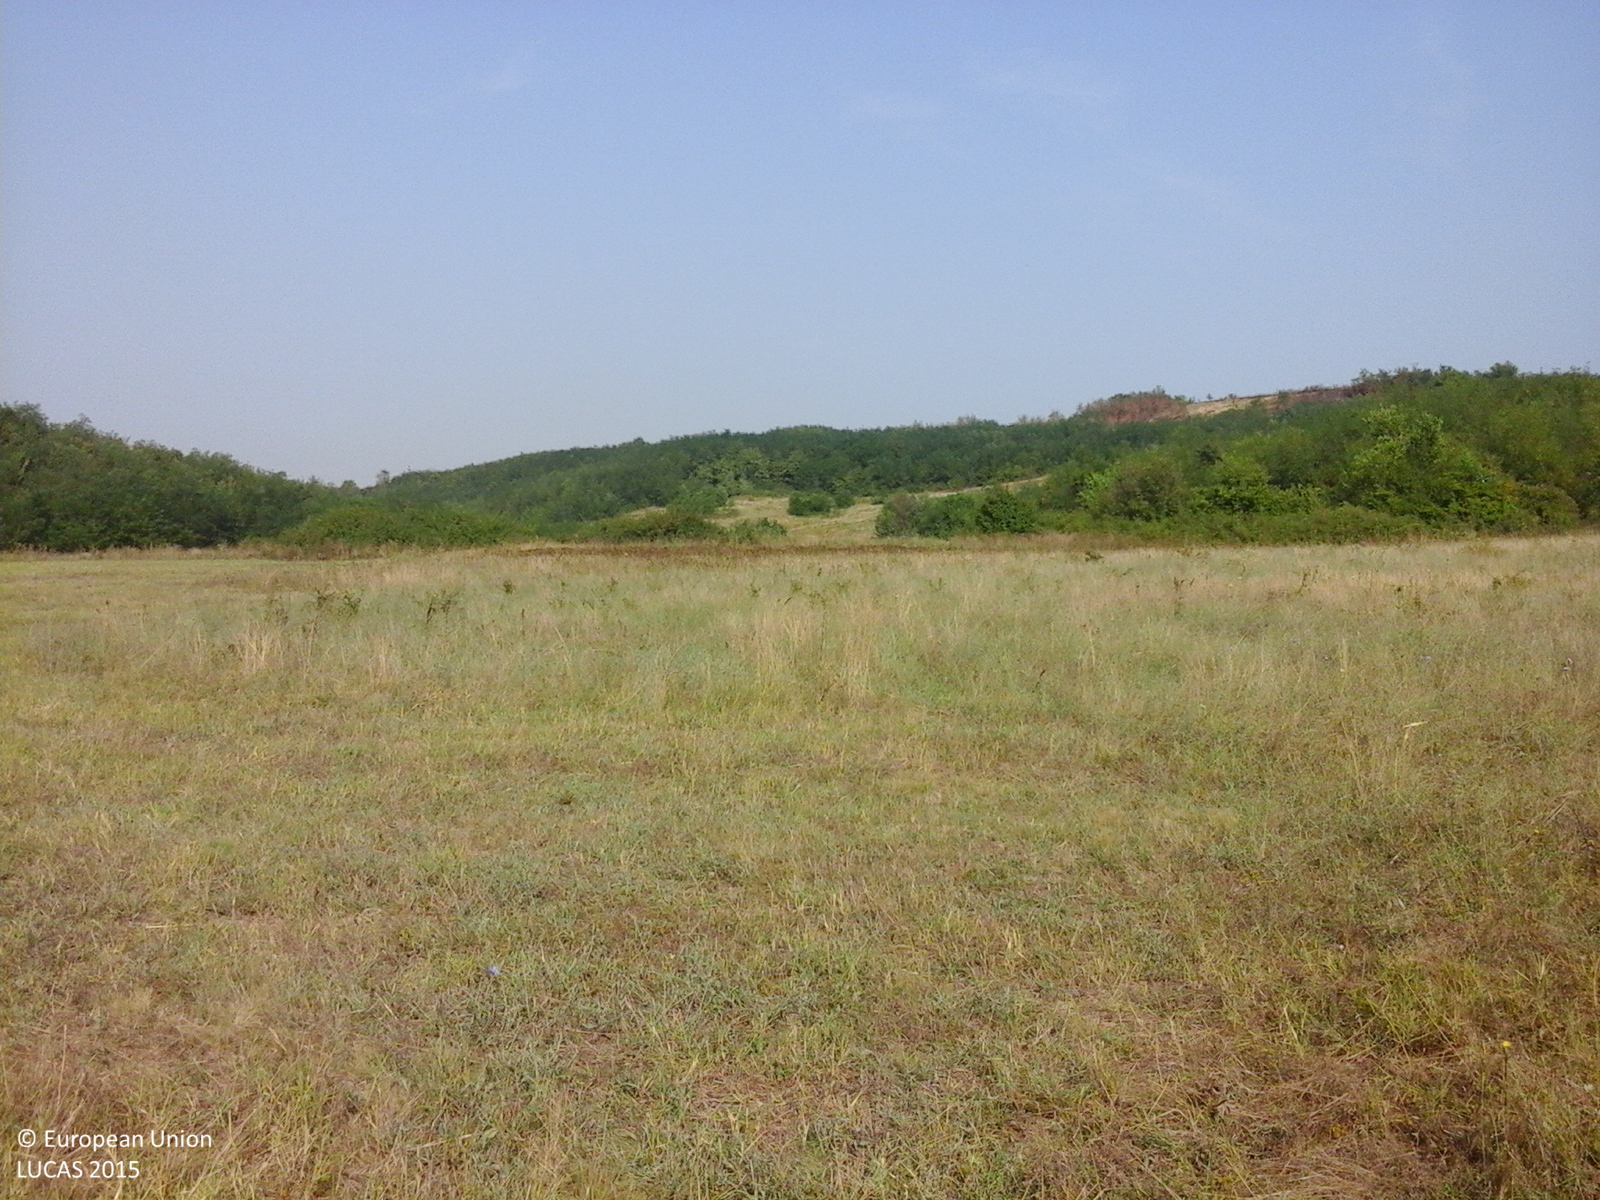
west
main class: Grassland
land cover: Grassland without tree/shrub cover
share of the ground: > 75 %
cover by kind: herbaceous plants 100 %
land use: Agriculture (excluding fallow land and kitchen gardens)
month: August
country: RO
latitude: 44.4852
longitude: 23.0857
